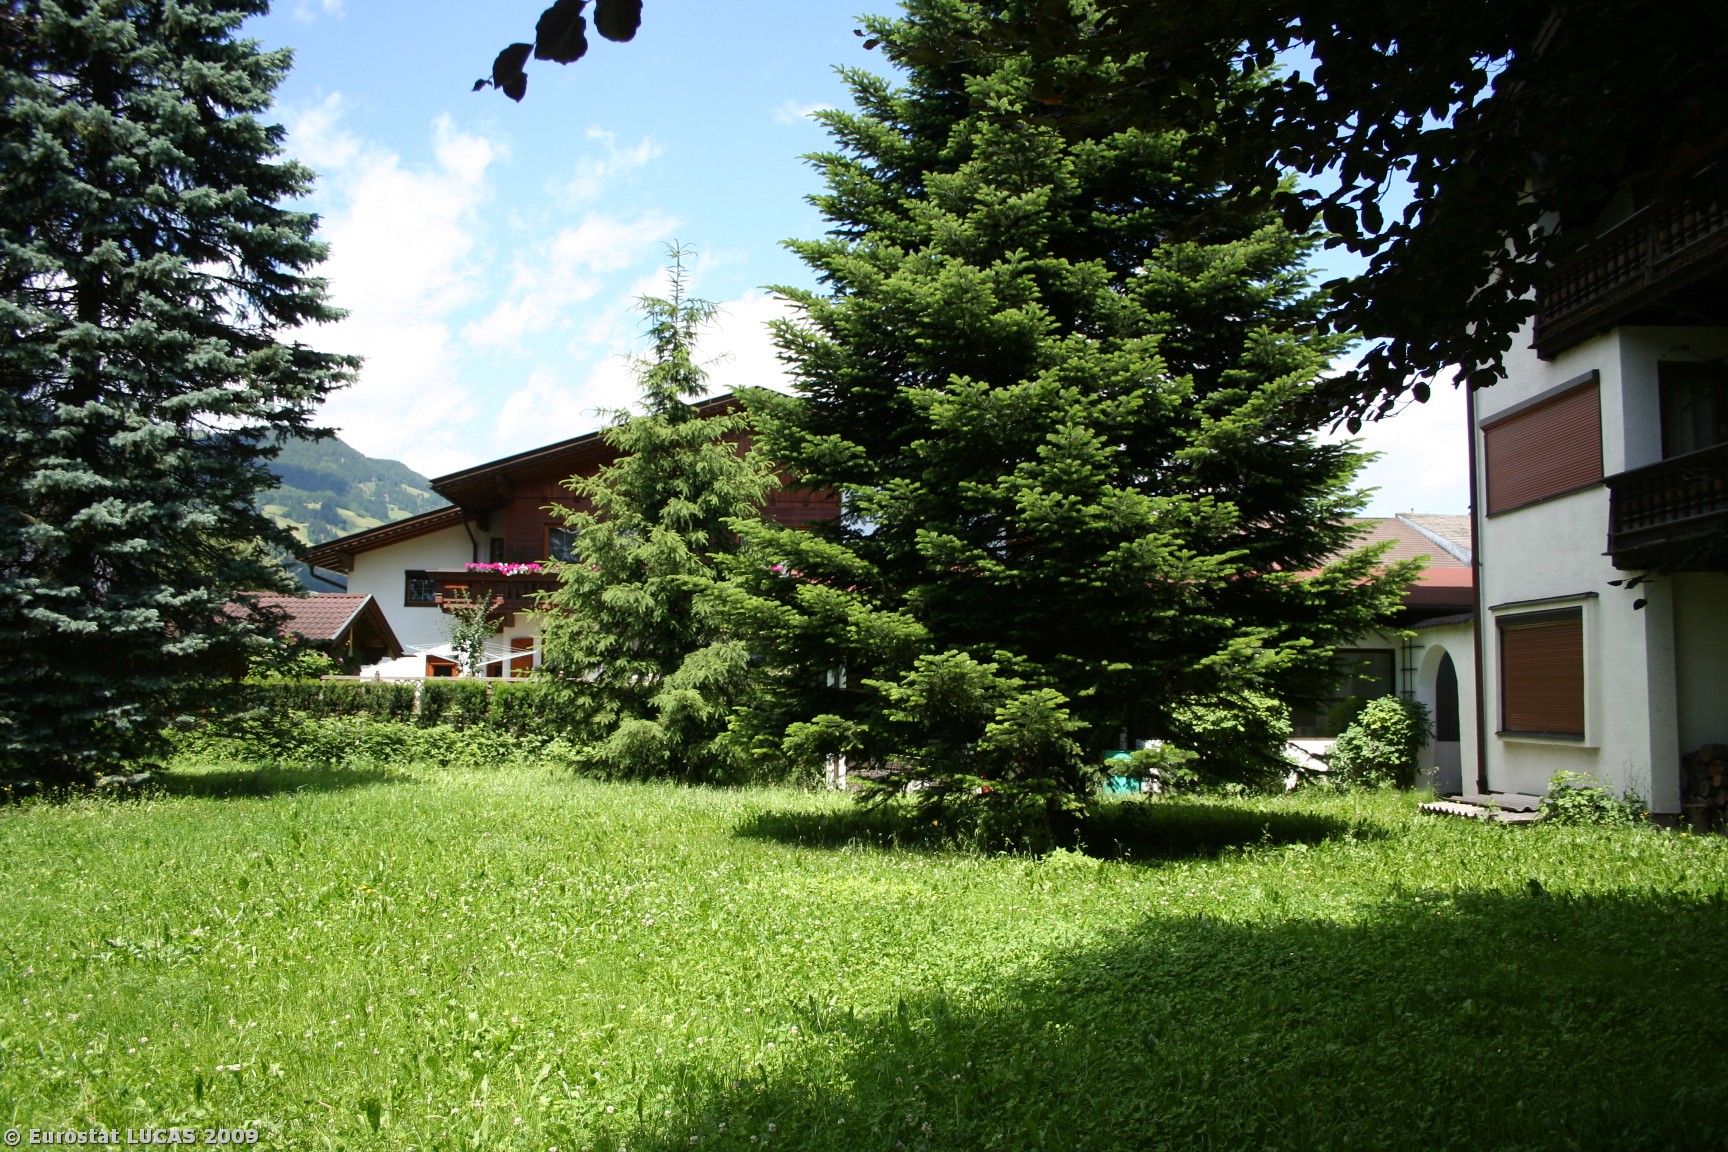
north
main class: Grassland
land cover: Grassland with sparse tree/shrub cover
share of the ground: > 75 %
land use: Agriculture (excluding fallow land and kitchen gardens)
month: June
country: AT
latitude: 47.3256
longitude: 11.8641
